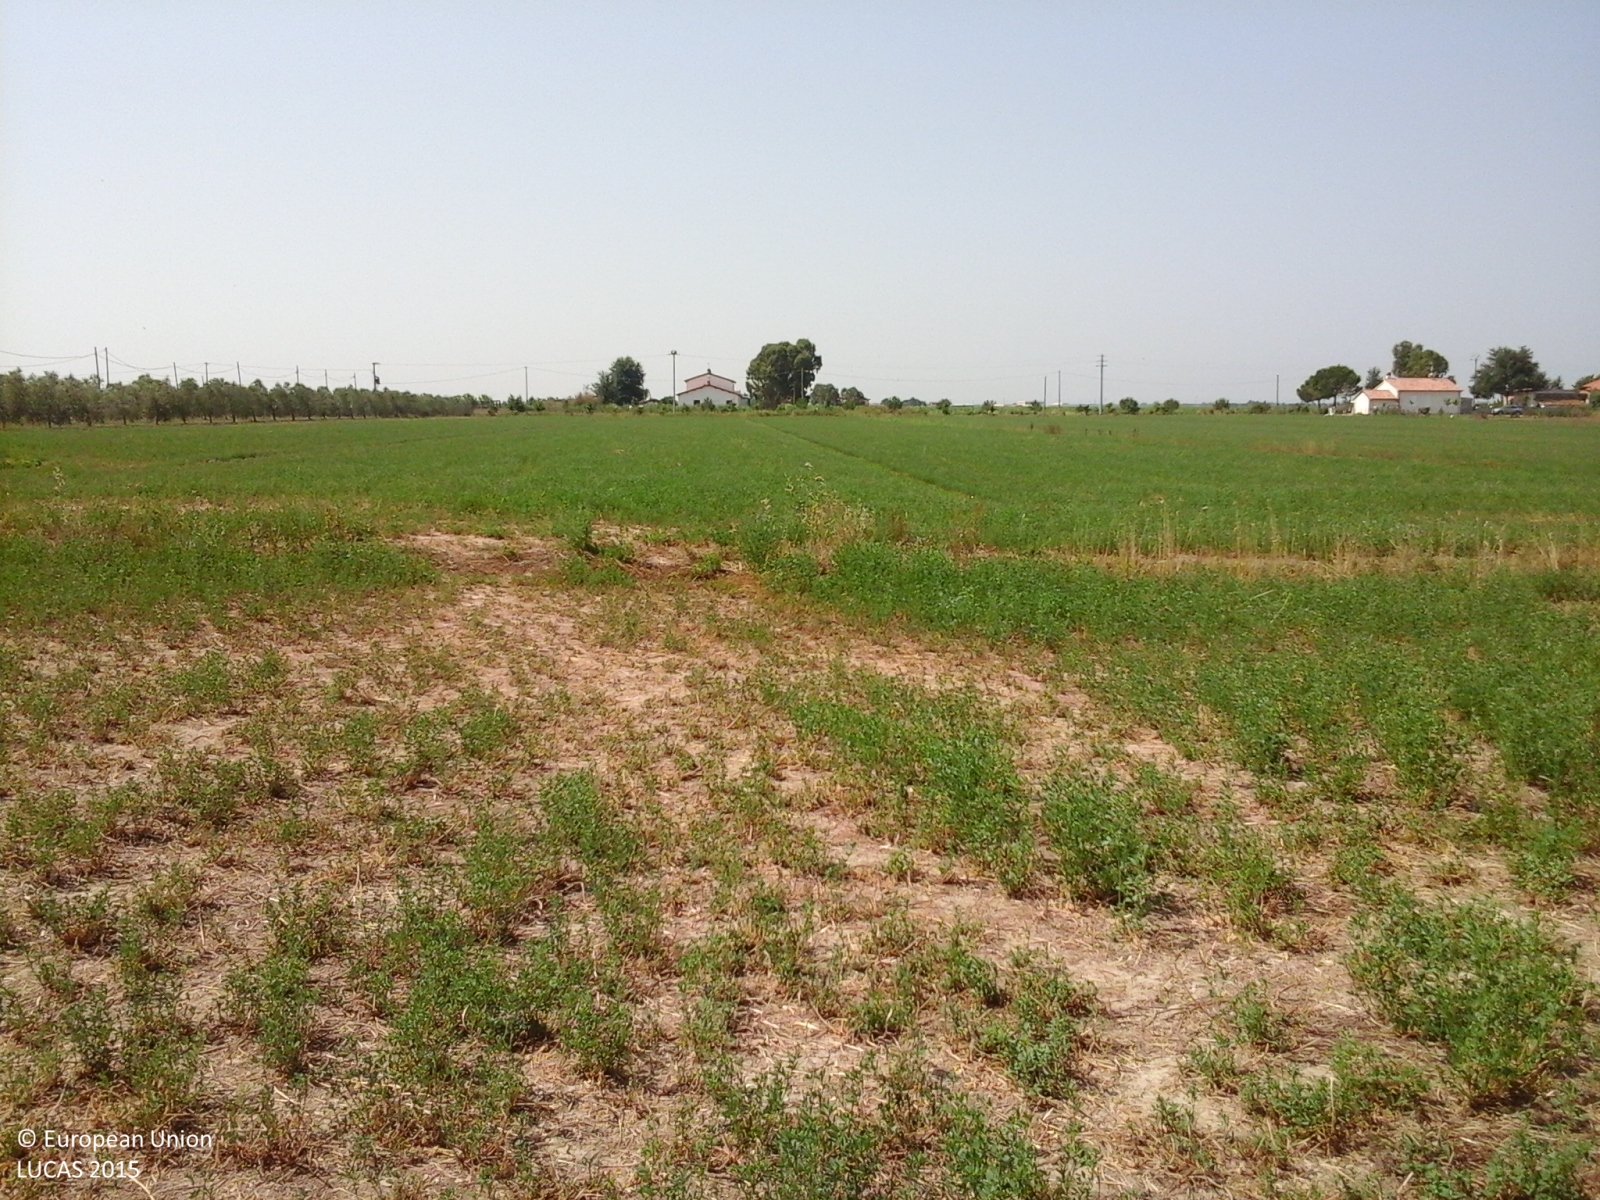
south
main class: Cropland
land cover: Lucerne
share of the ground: > 75 %
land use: Agriculture (excluding fallow land and kitchen gardens)
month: July
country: IT
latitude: 42.7571
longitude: 11.0352
